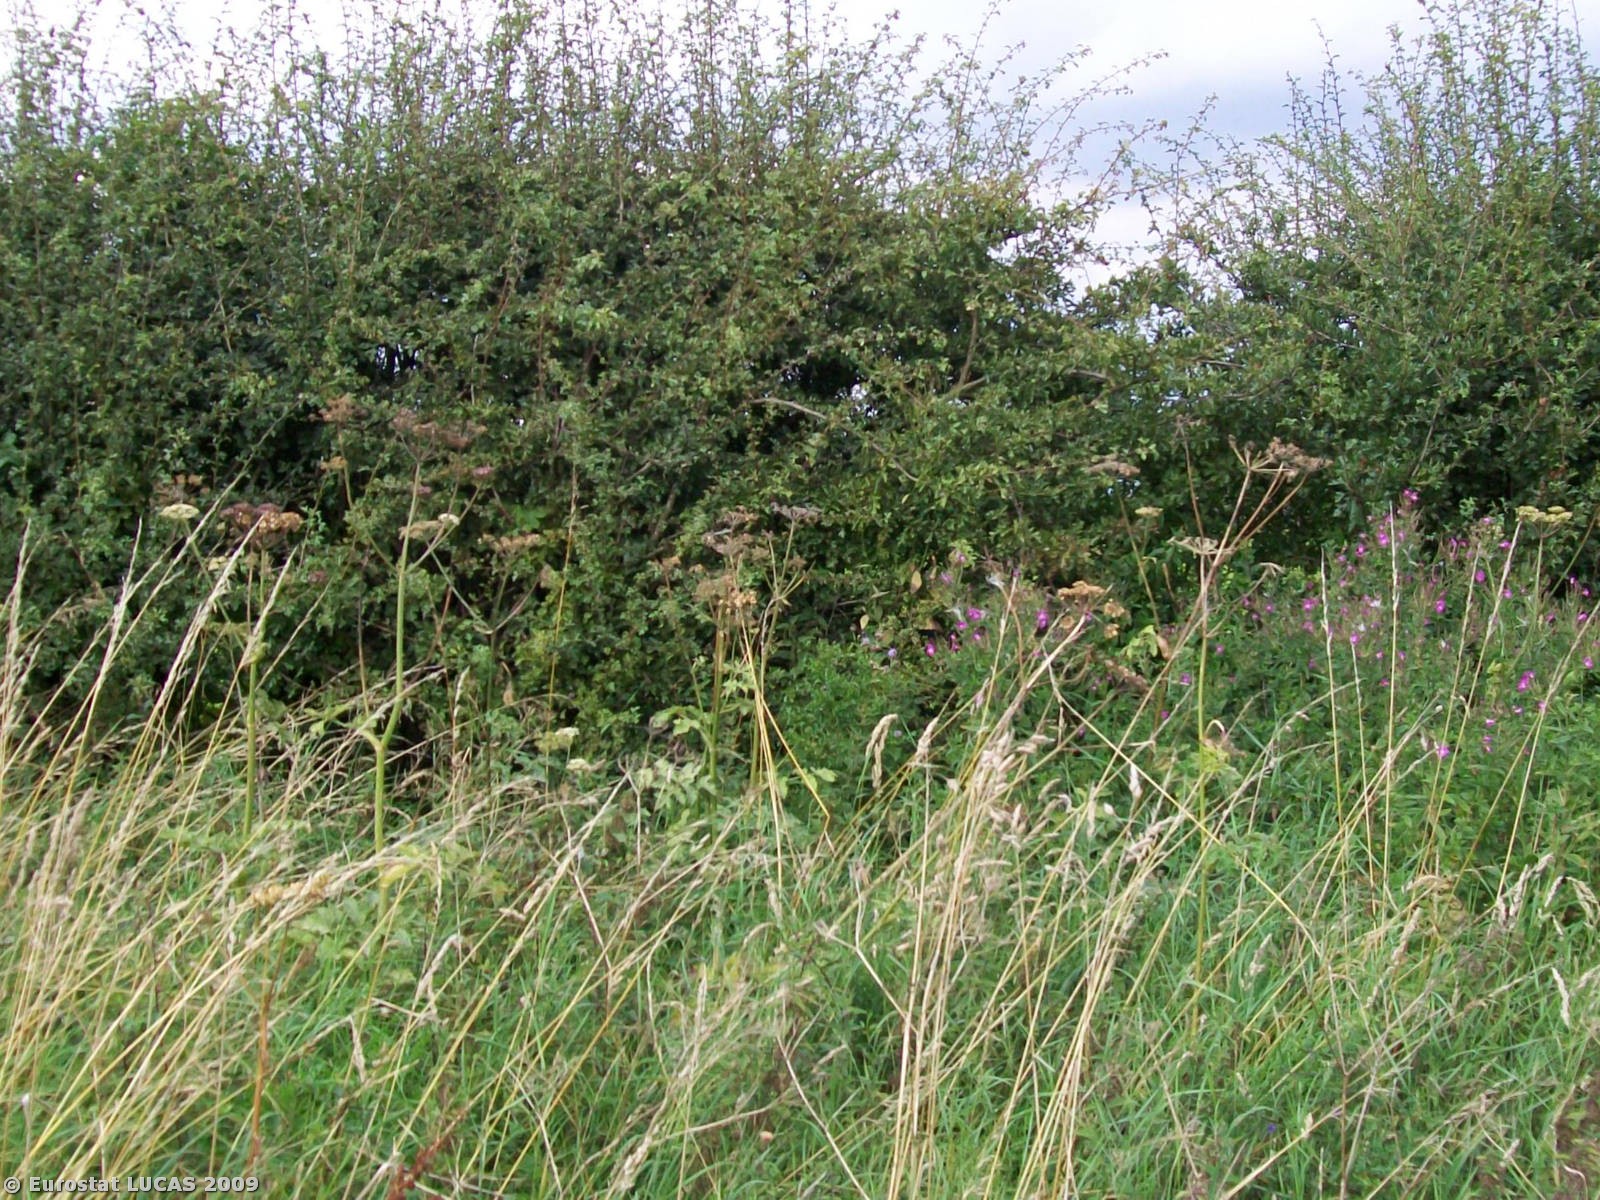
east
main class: Grassland
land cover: Grassland without tree/shrub cover
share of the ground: > 75 %
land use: Unused
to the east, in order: Grassland without tree/shrub cover; Managed hedges; Grassland without tree/shrub cover; Electric lines; Grassland without tree/shrub cover
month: August
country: GB
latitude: 53.3668
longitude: -1.2428
